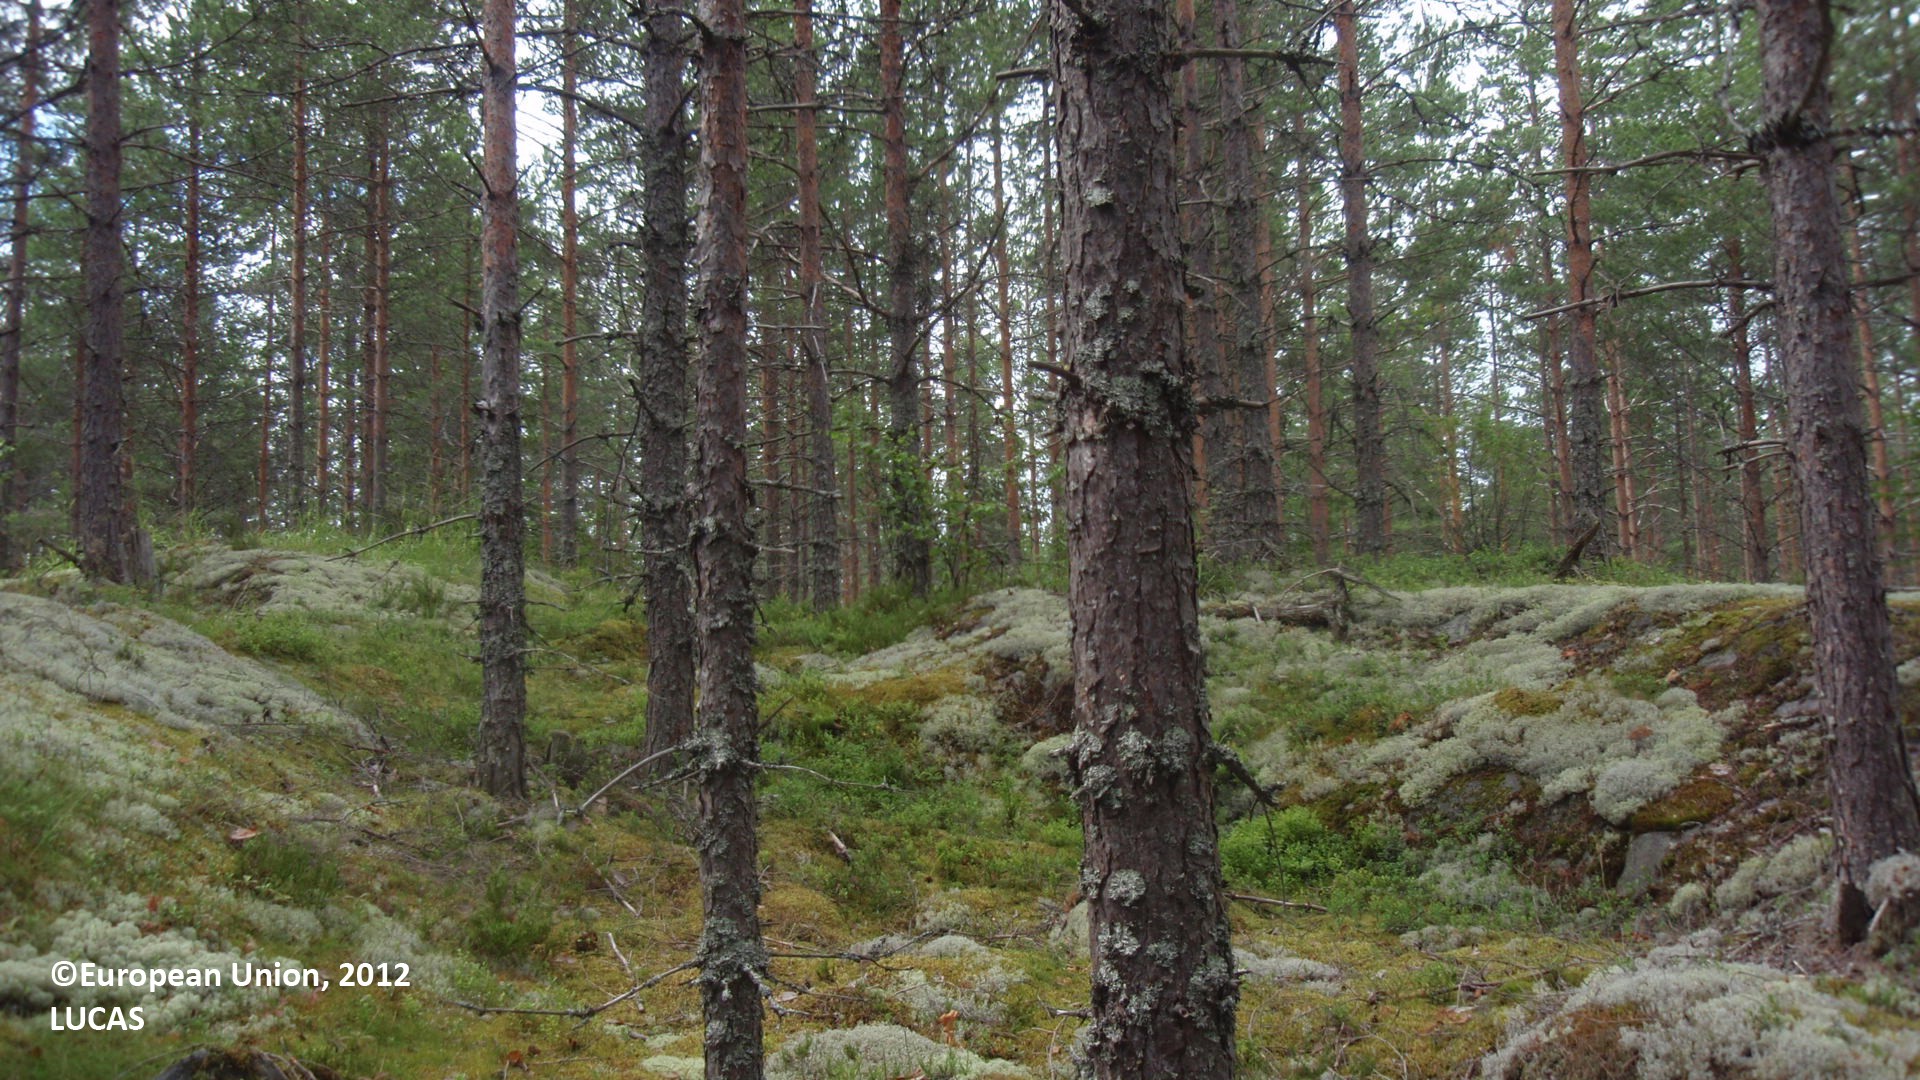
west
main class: Woodland
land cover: Pine dominated coniferous woodland
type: boreal forest
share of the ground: 50 - 75 %
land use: Forestry
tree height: > 5 m
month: July
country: FI
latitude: 61.4235
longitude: 28.4066
